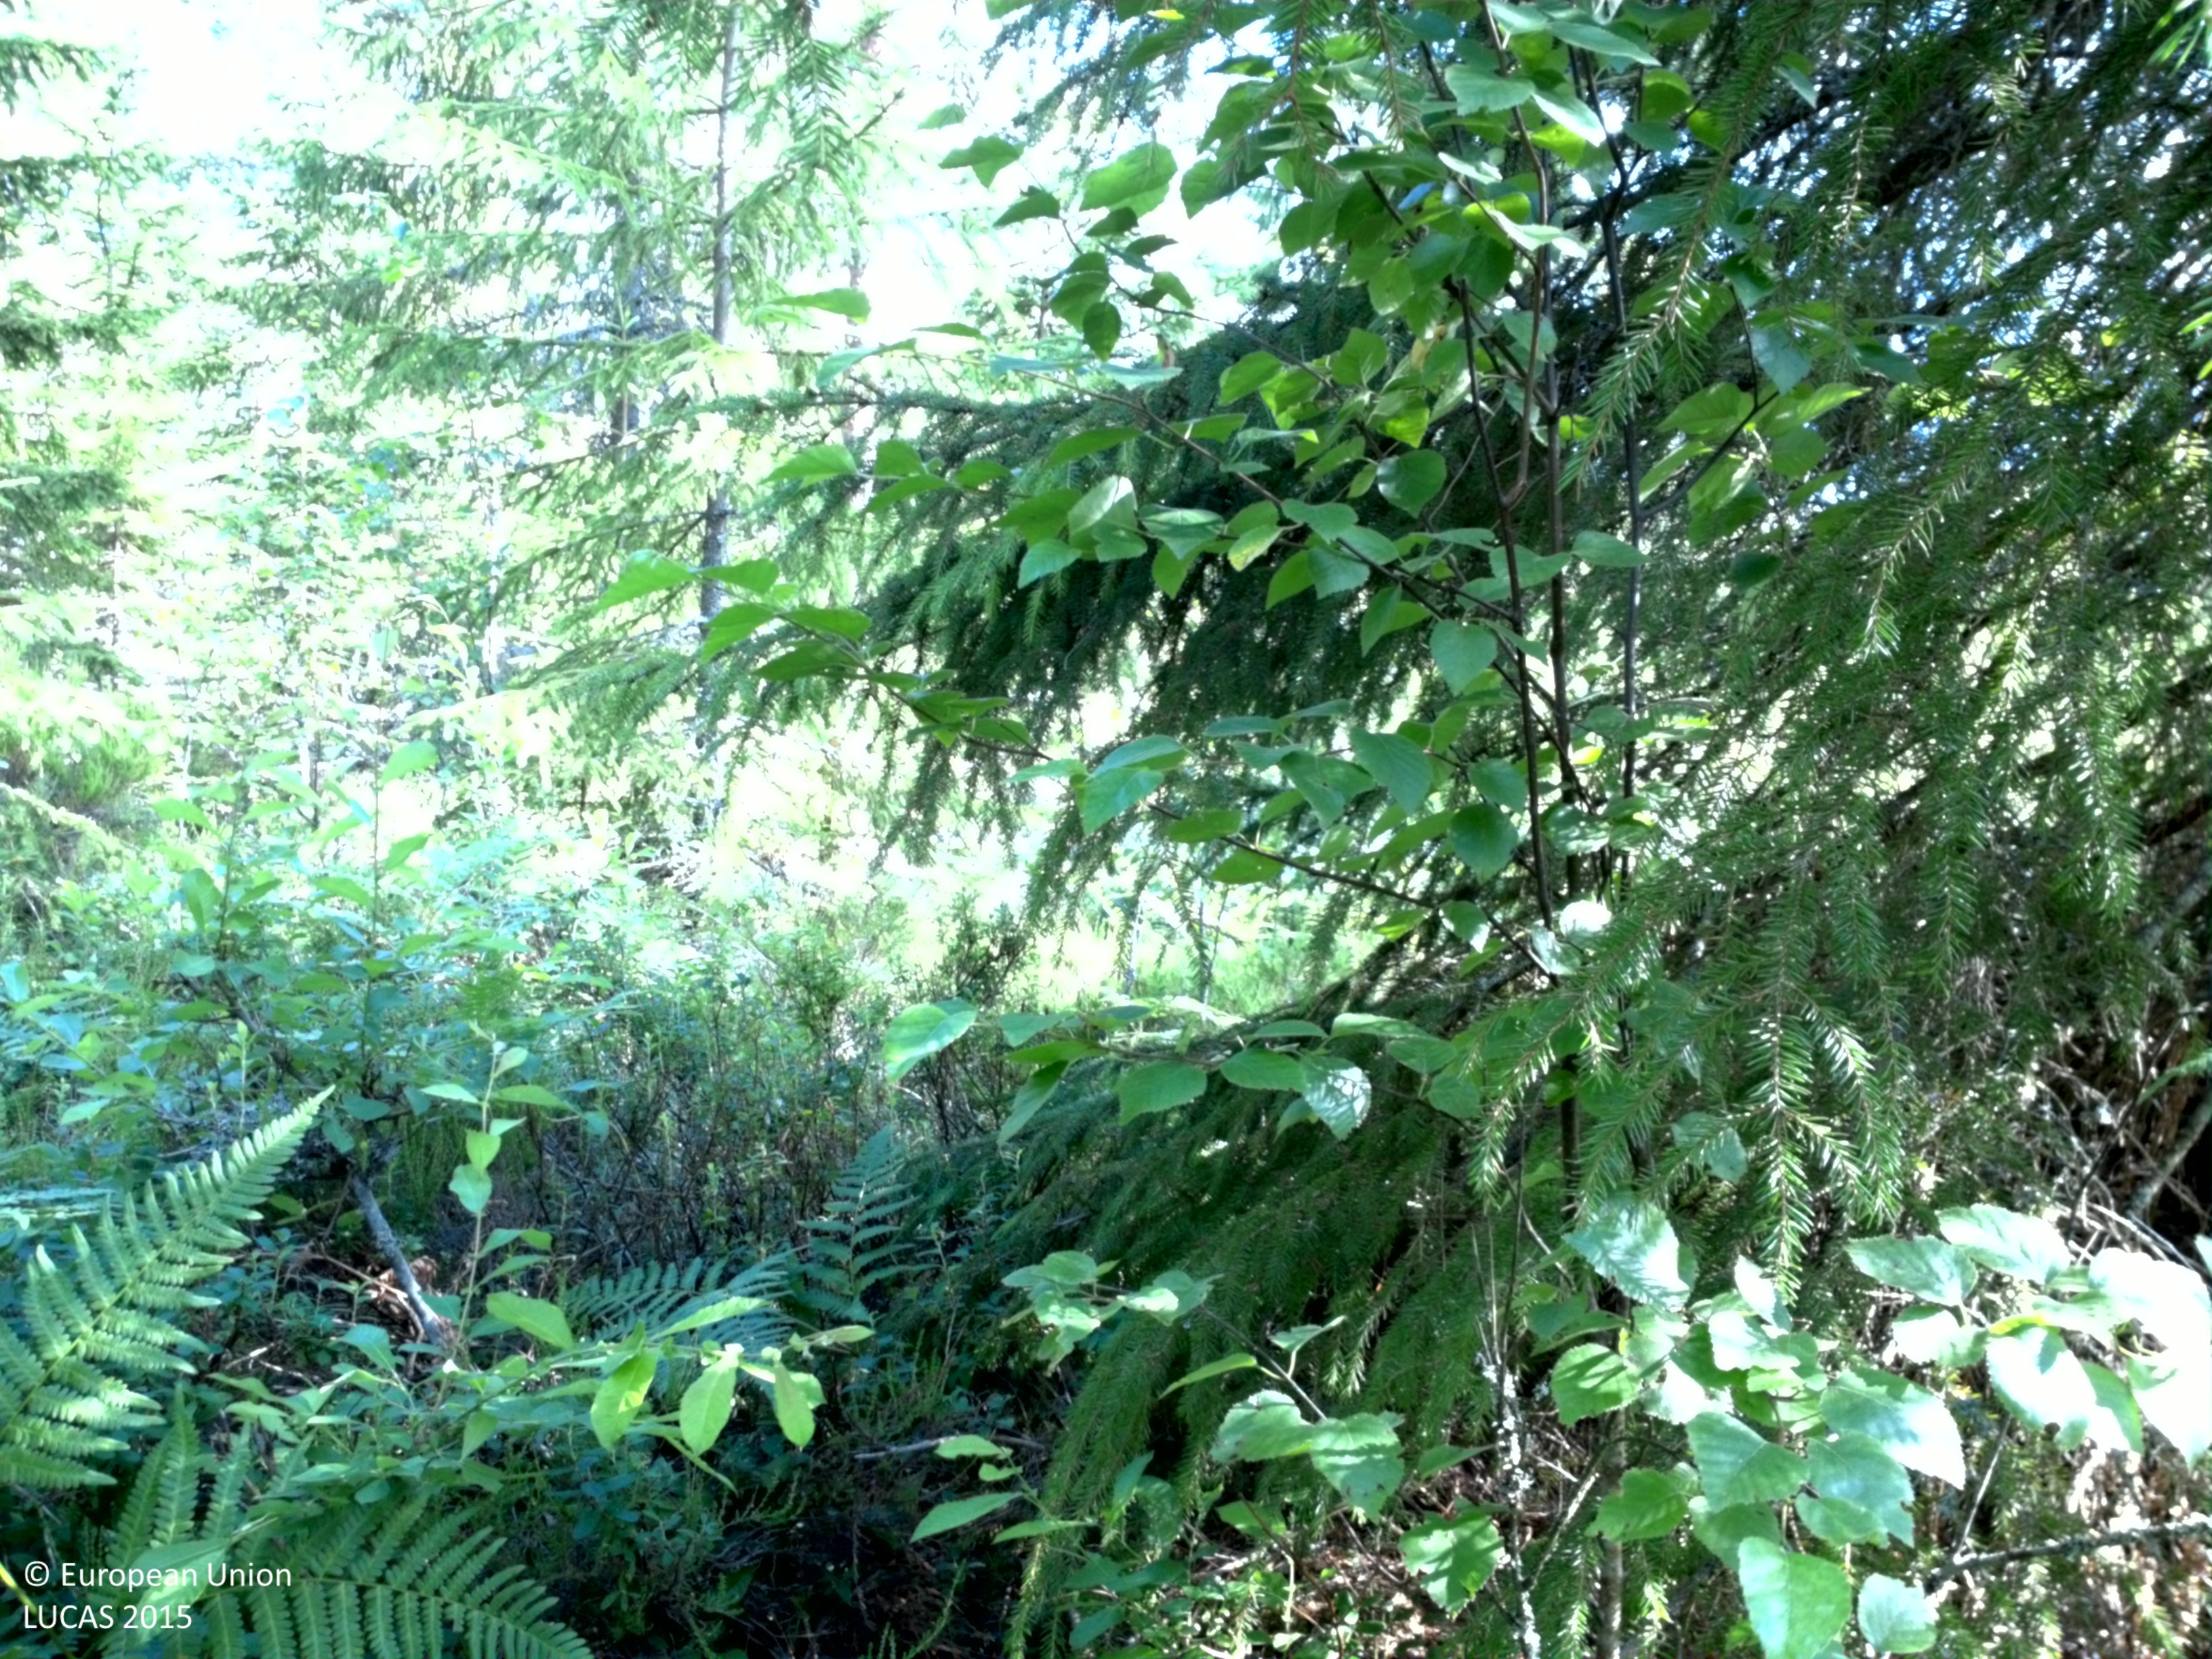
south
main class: Woodland
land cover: Spruce dominated coniferous woodland
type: boreal forest
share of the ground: 50 - 75 %
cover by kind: coniferous forest trees 60 %, herbaceous plants 25 %, shrubs 10 %, lichens and mosses 5 %
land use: Forestry
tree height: < 5 m
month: July
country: SE
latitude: 58.8921
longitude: 14.7647
